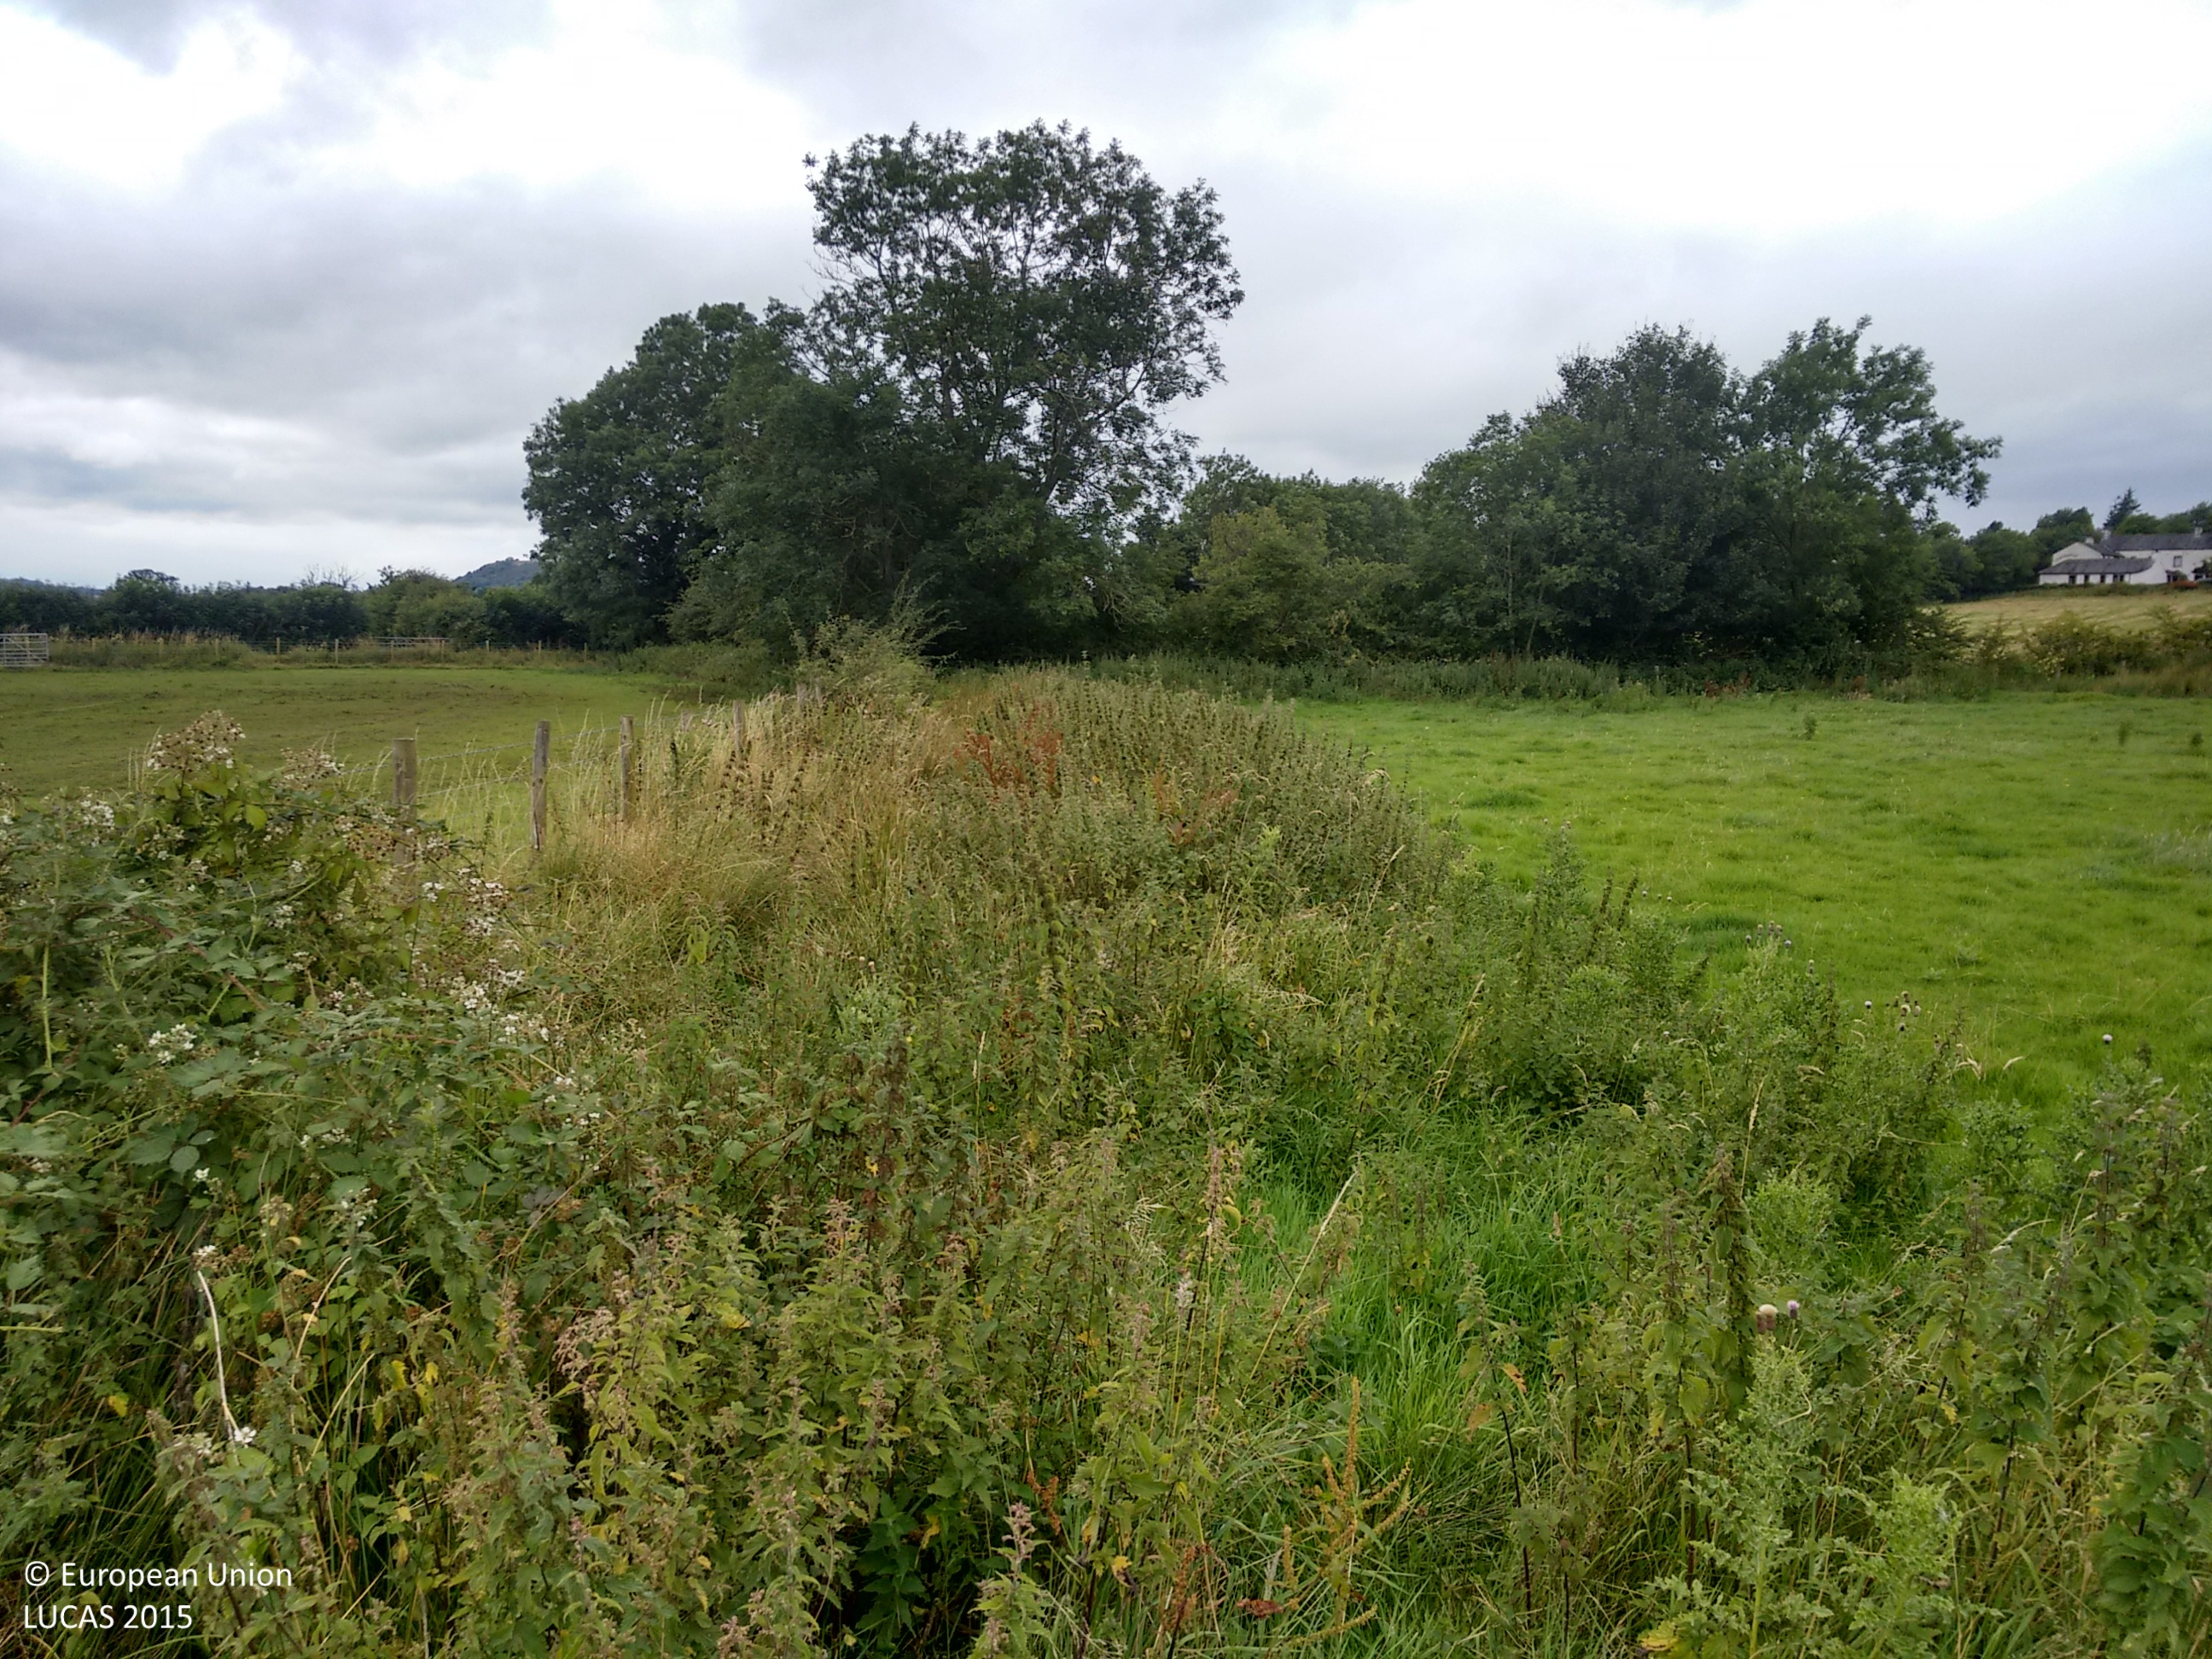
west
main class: Grassland
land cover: Grassland without tree/shrub cover
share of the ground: > 75 %
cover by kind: herbaceous plants 100 %
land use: Agriculture (excluding fallow land and kitchen gardens)
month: August
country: GB
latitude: 54.6796
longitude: -3.2125
